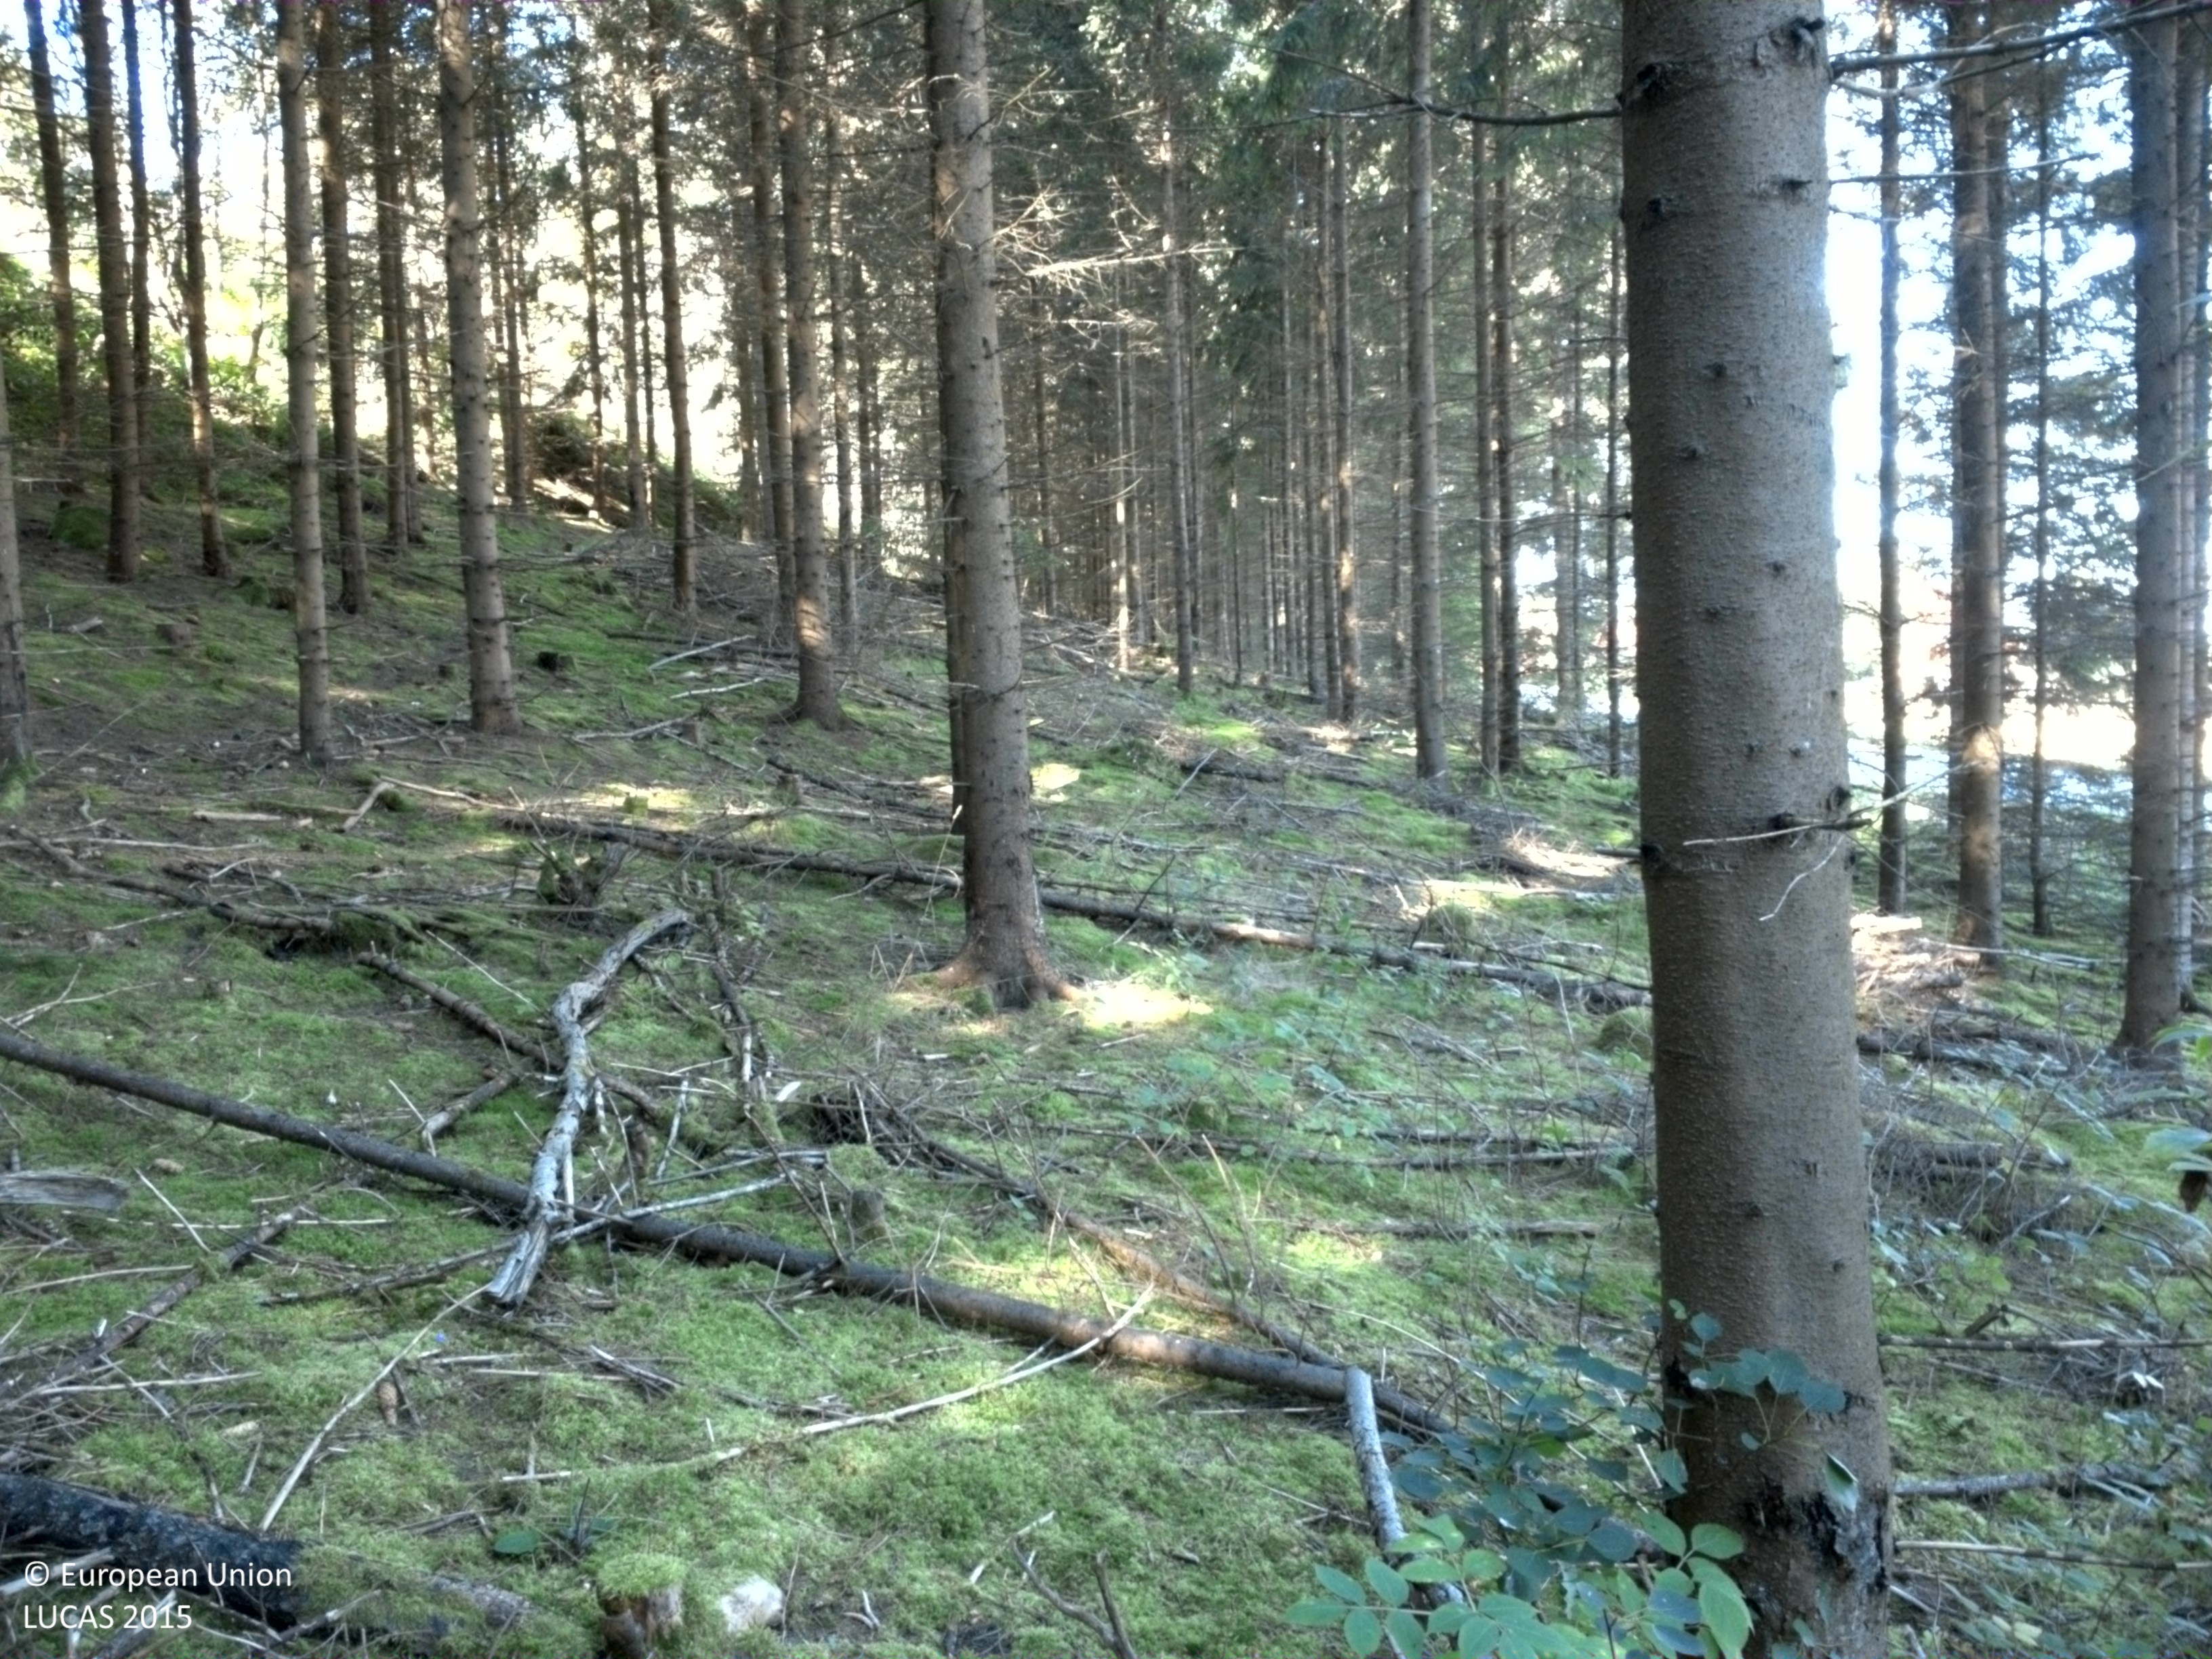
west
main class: Woodland
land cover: Spruce dominated coniferous woodland
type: boreal forest
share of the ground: > 75 %
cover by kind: coniferous forest trees 90 %, herbaceous plants 5 %, lichens and mosses 5 %
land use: Forestry
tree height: > 5 m
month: August
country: SE
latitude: 59.6036
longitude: 17.4544
